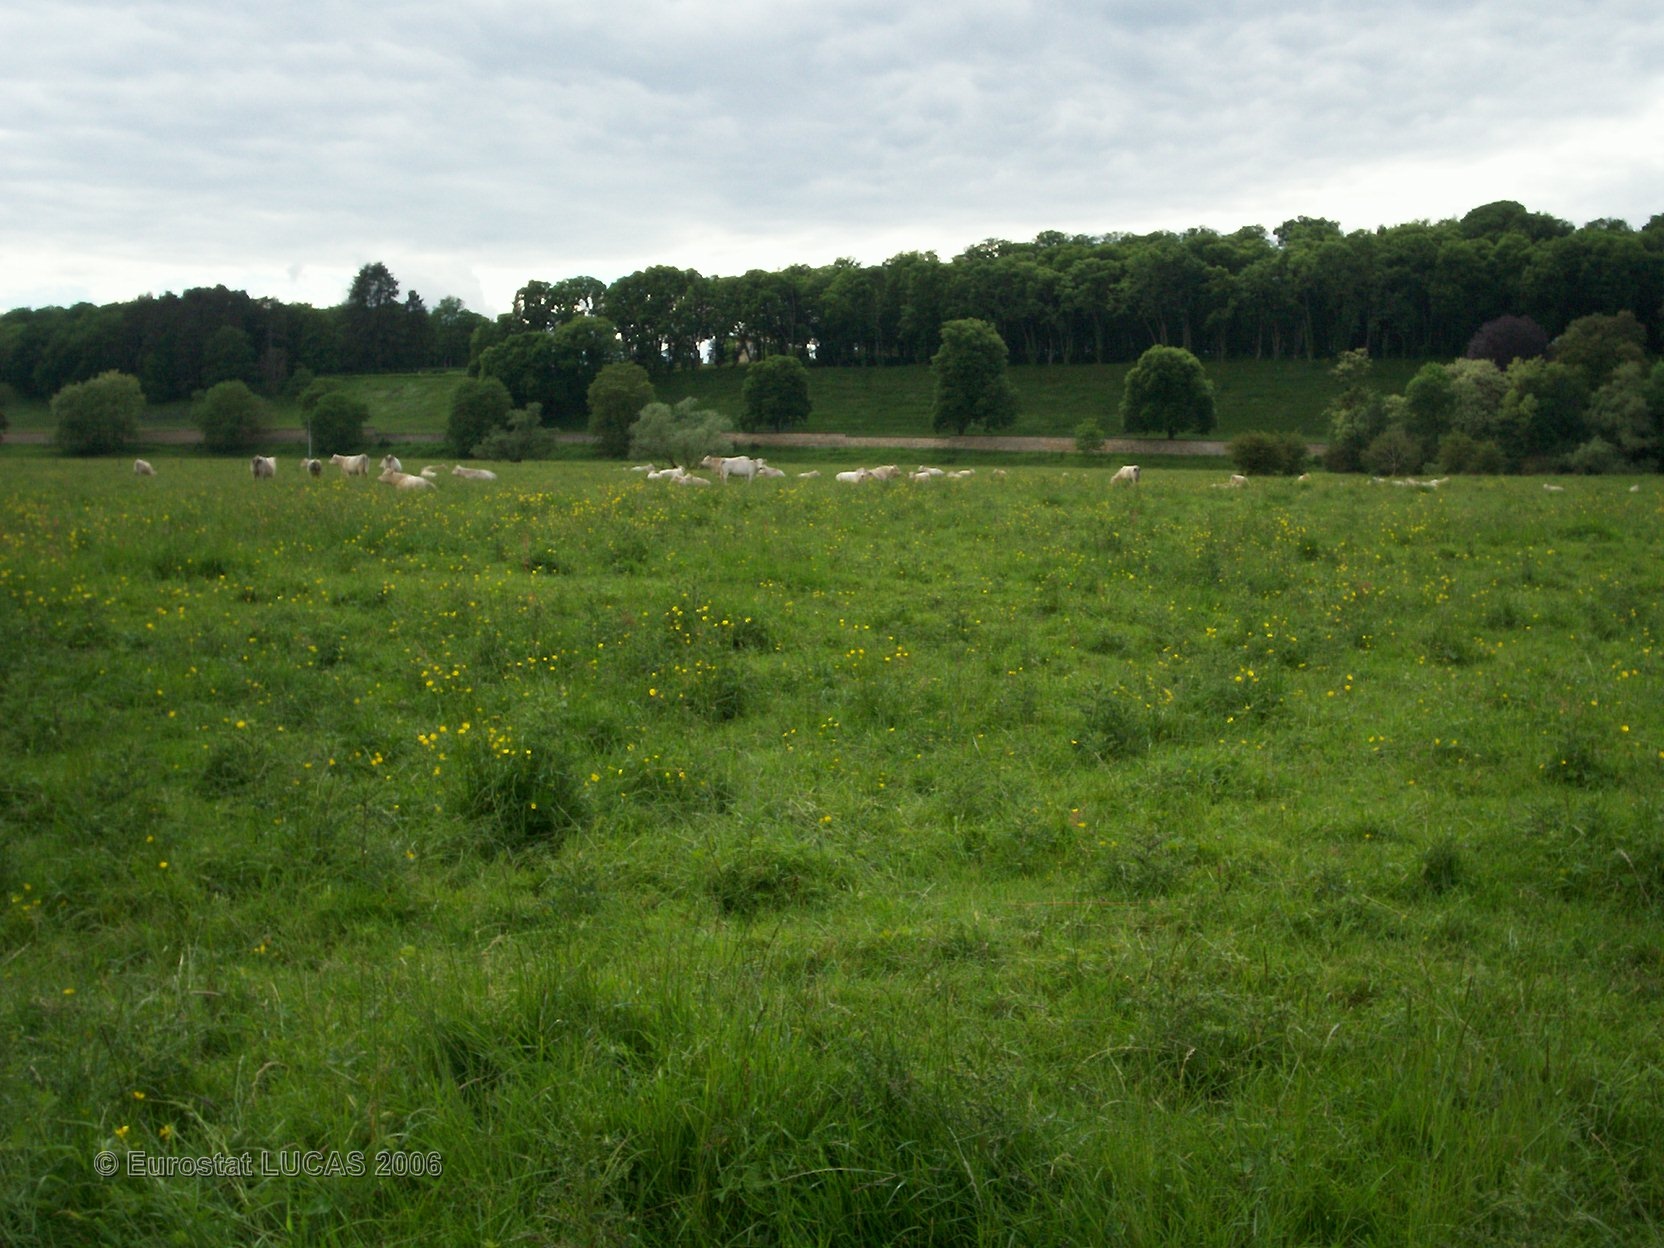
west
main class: Grassland
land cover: Grassland without tree/shrub cover
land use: Agriculture (excluding fallow land and kitchen gardens)
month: May
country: FR
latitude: 46.9023
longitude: 3.0518
